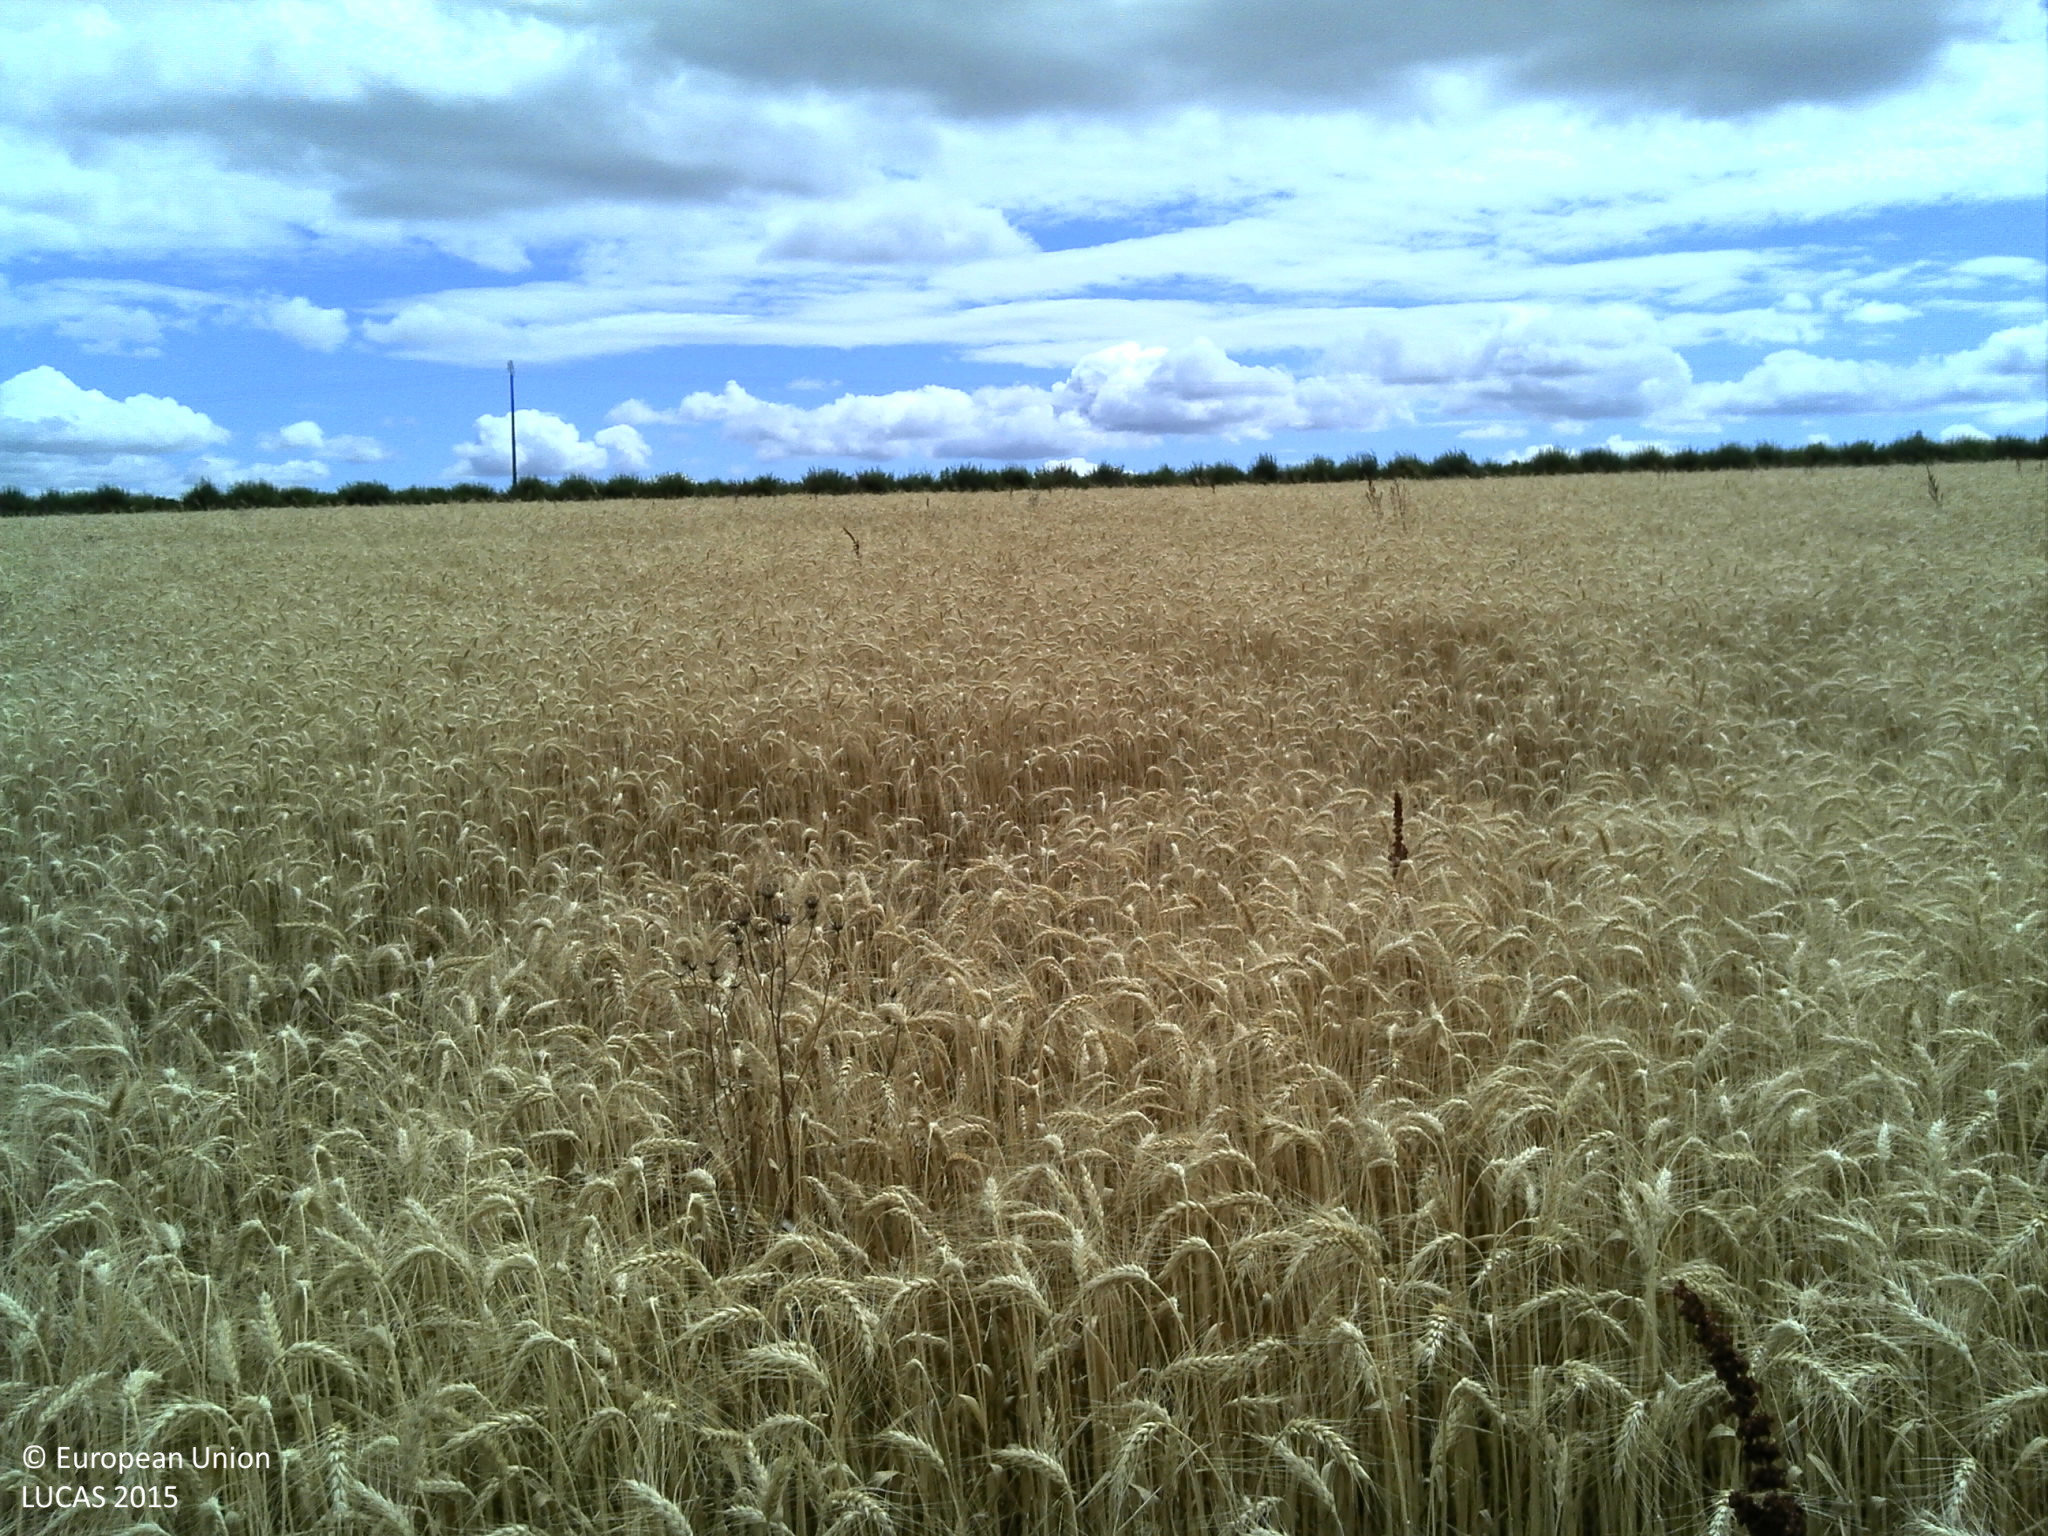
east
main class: Cropland
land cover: Durum wheat
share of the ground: > 75 %
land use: Agriculture (excluding fallow land and kitchen gardens)
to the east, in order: Durum wheat; Abandoned hedges; Electric lines; Grassland without tree/shrub cover
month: July
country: FR
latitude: 48.1693
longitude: 6.0068
